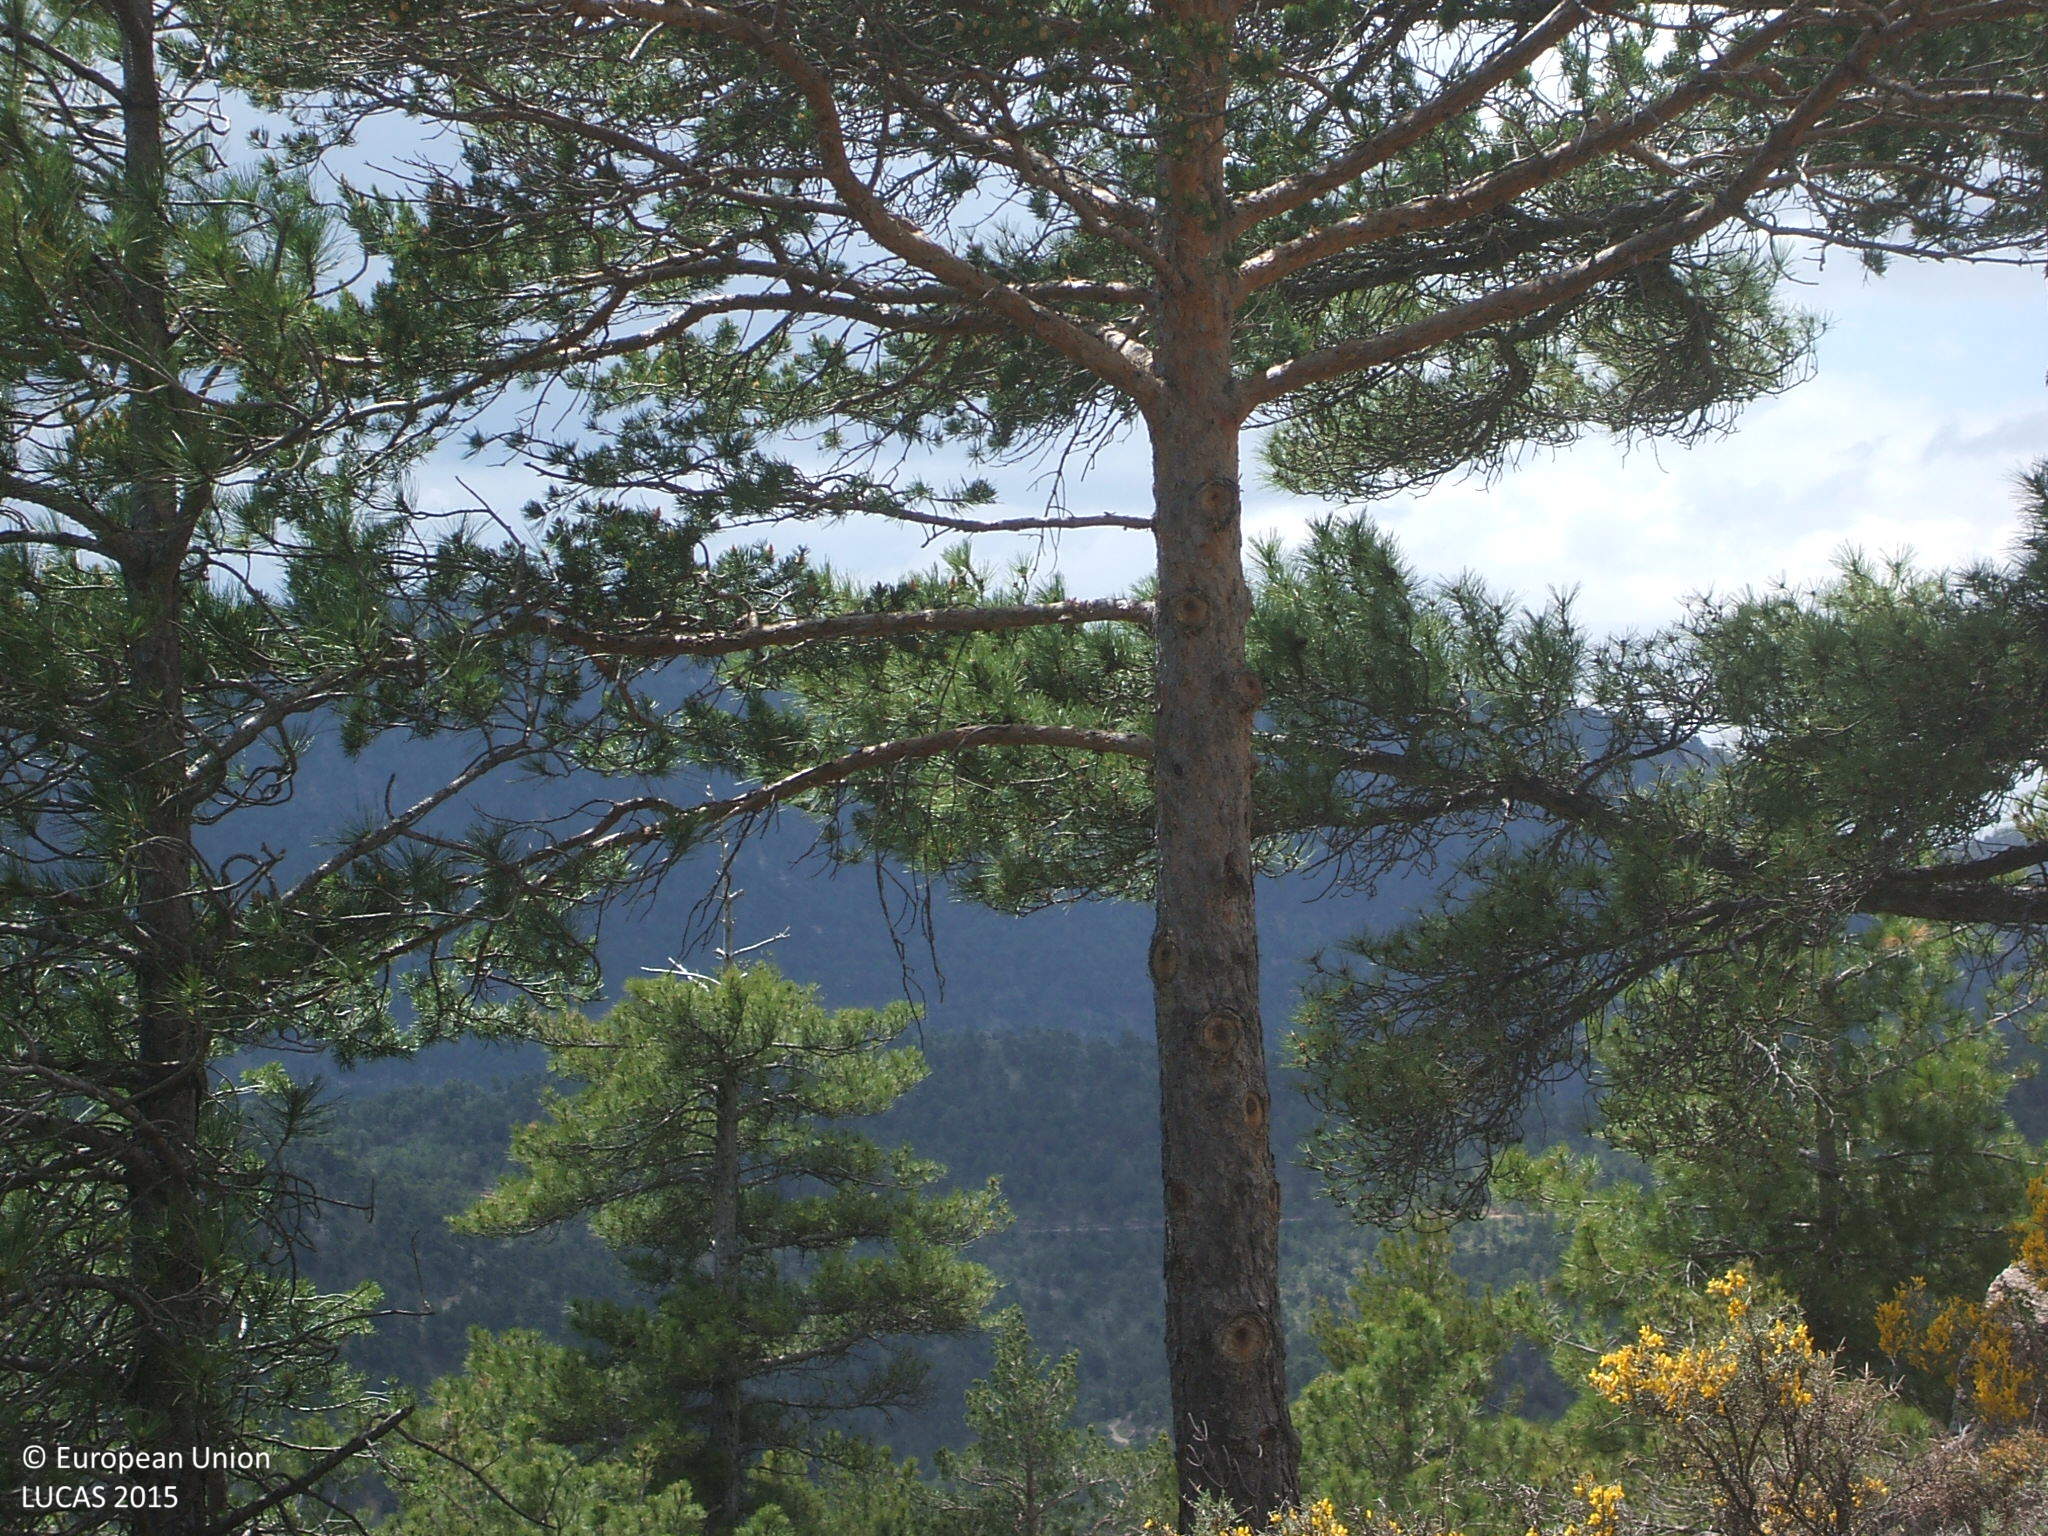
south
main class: Woodland
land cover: Pine dominated coniferous woodland
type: coniferous forest of the mediterranean region
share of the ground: 25 - 50 %
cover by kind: consolidated bare surface 50 %, coniferous forest trees 40 %, shrubs 10 %
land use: Semi-natural and natural areas not in use
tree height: > 5 m
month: May
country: ES
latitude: 40.0546
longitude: -0.9437
